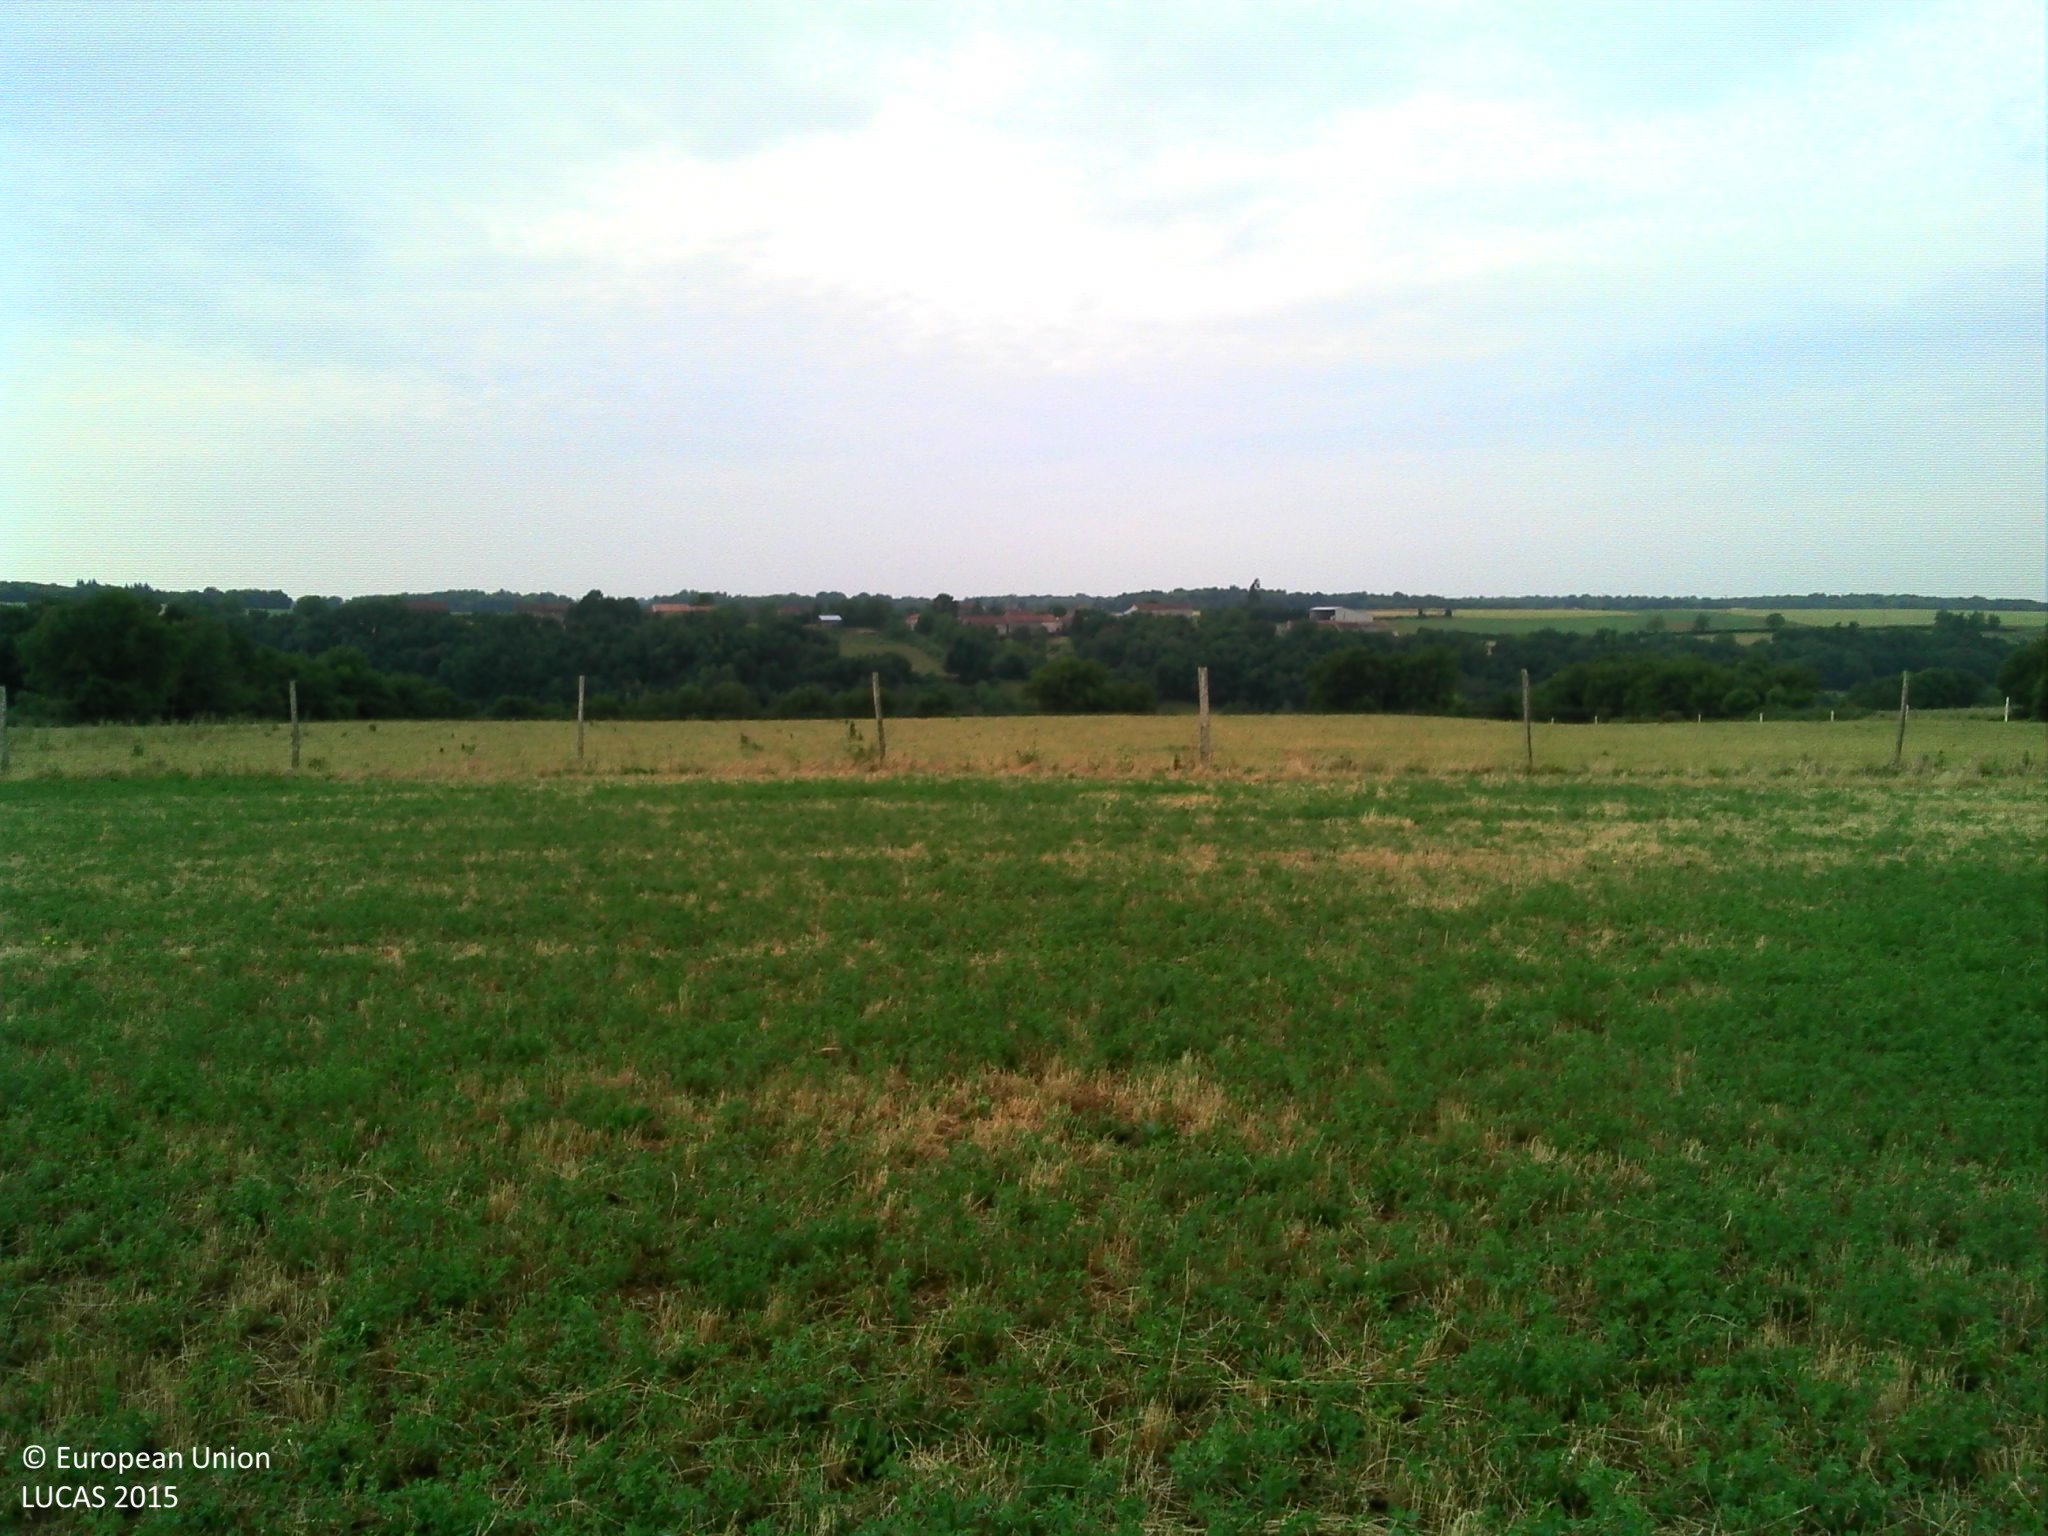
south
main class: Cropland
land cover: Lucerne
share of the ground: > 75 %
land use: Agriculture (excluding fallow land and kitchen gardens)
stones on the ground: < 10 %
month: June
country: FR
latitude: 45.9809
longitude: 0.2892
